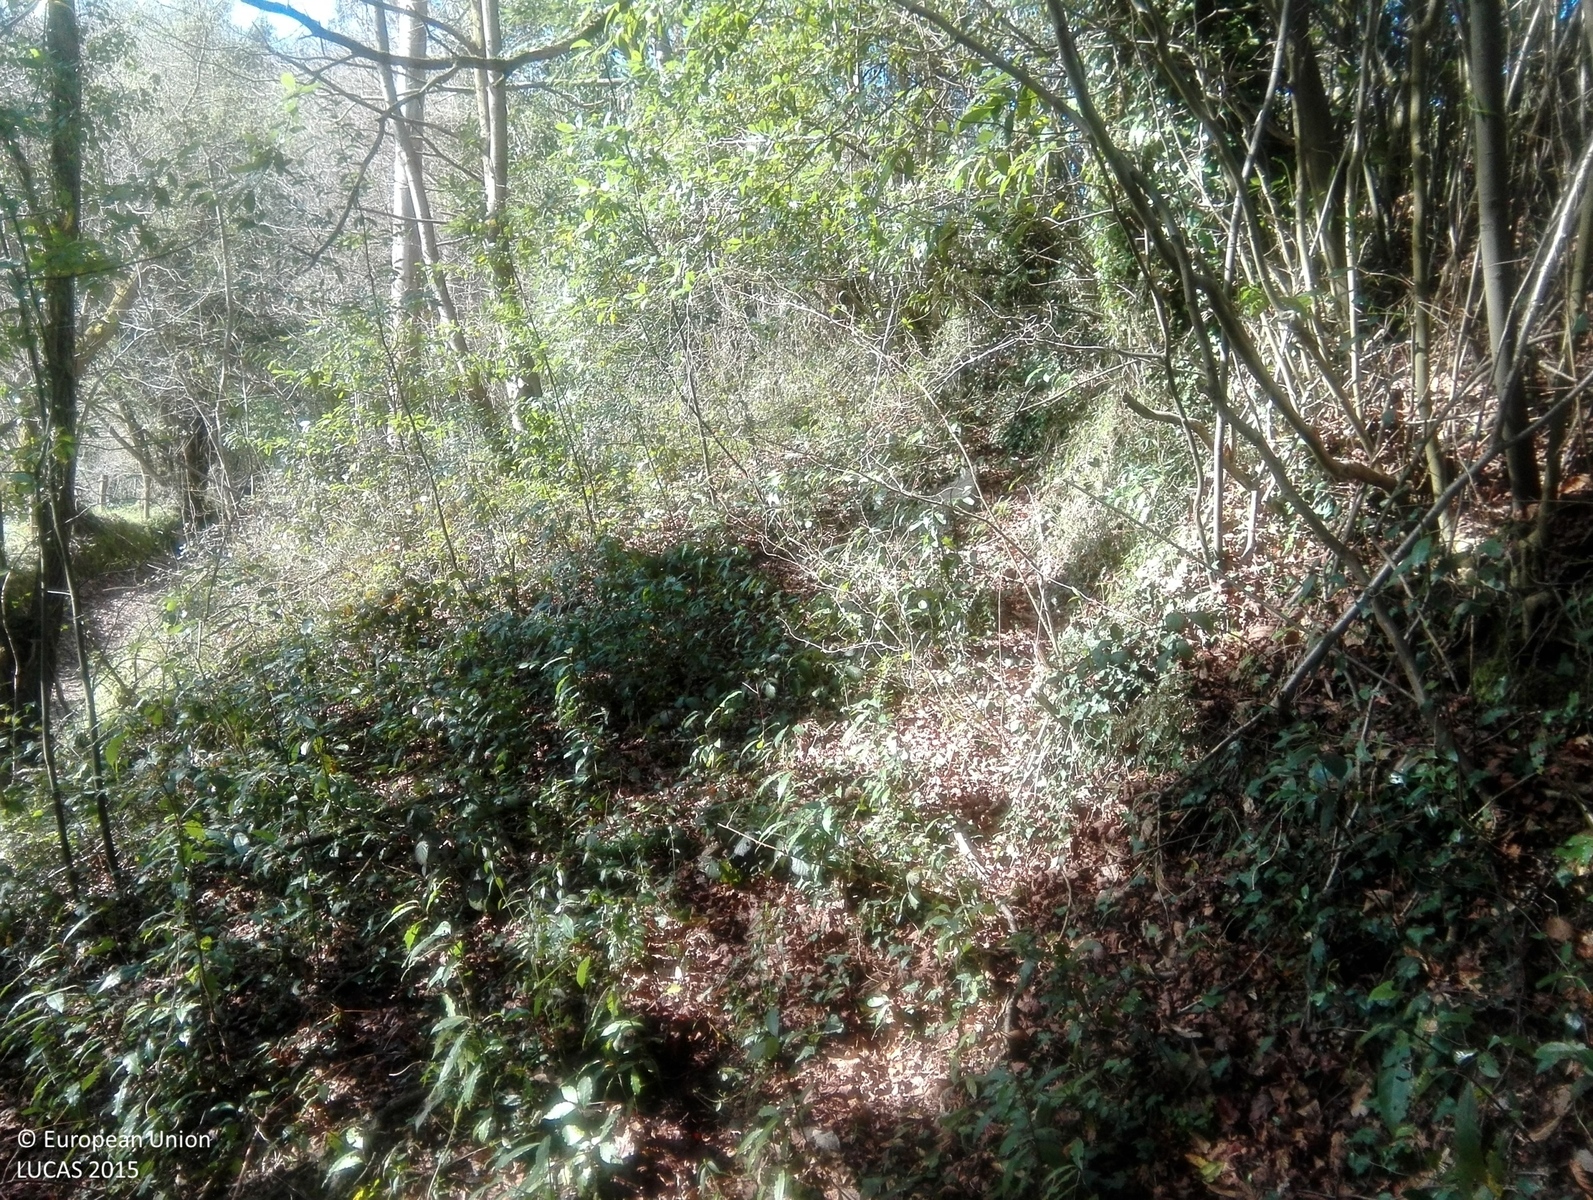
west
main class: Woodland
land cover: Broadleaved woodland
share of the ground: > 75 %
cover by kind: broadleaved forest trees 100 %
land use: Semi-natural and natural areas not in use
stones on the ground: < 10 %
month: April
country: ES
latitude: 43.4139
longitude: -5.6320
